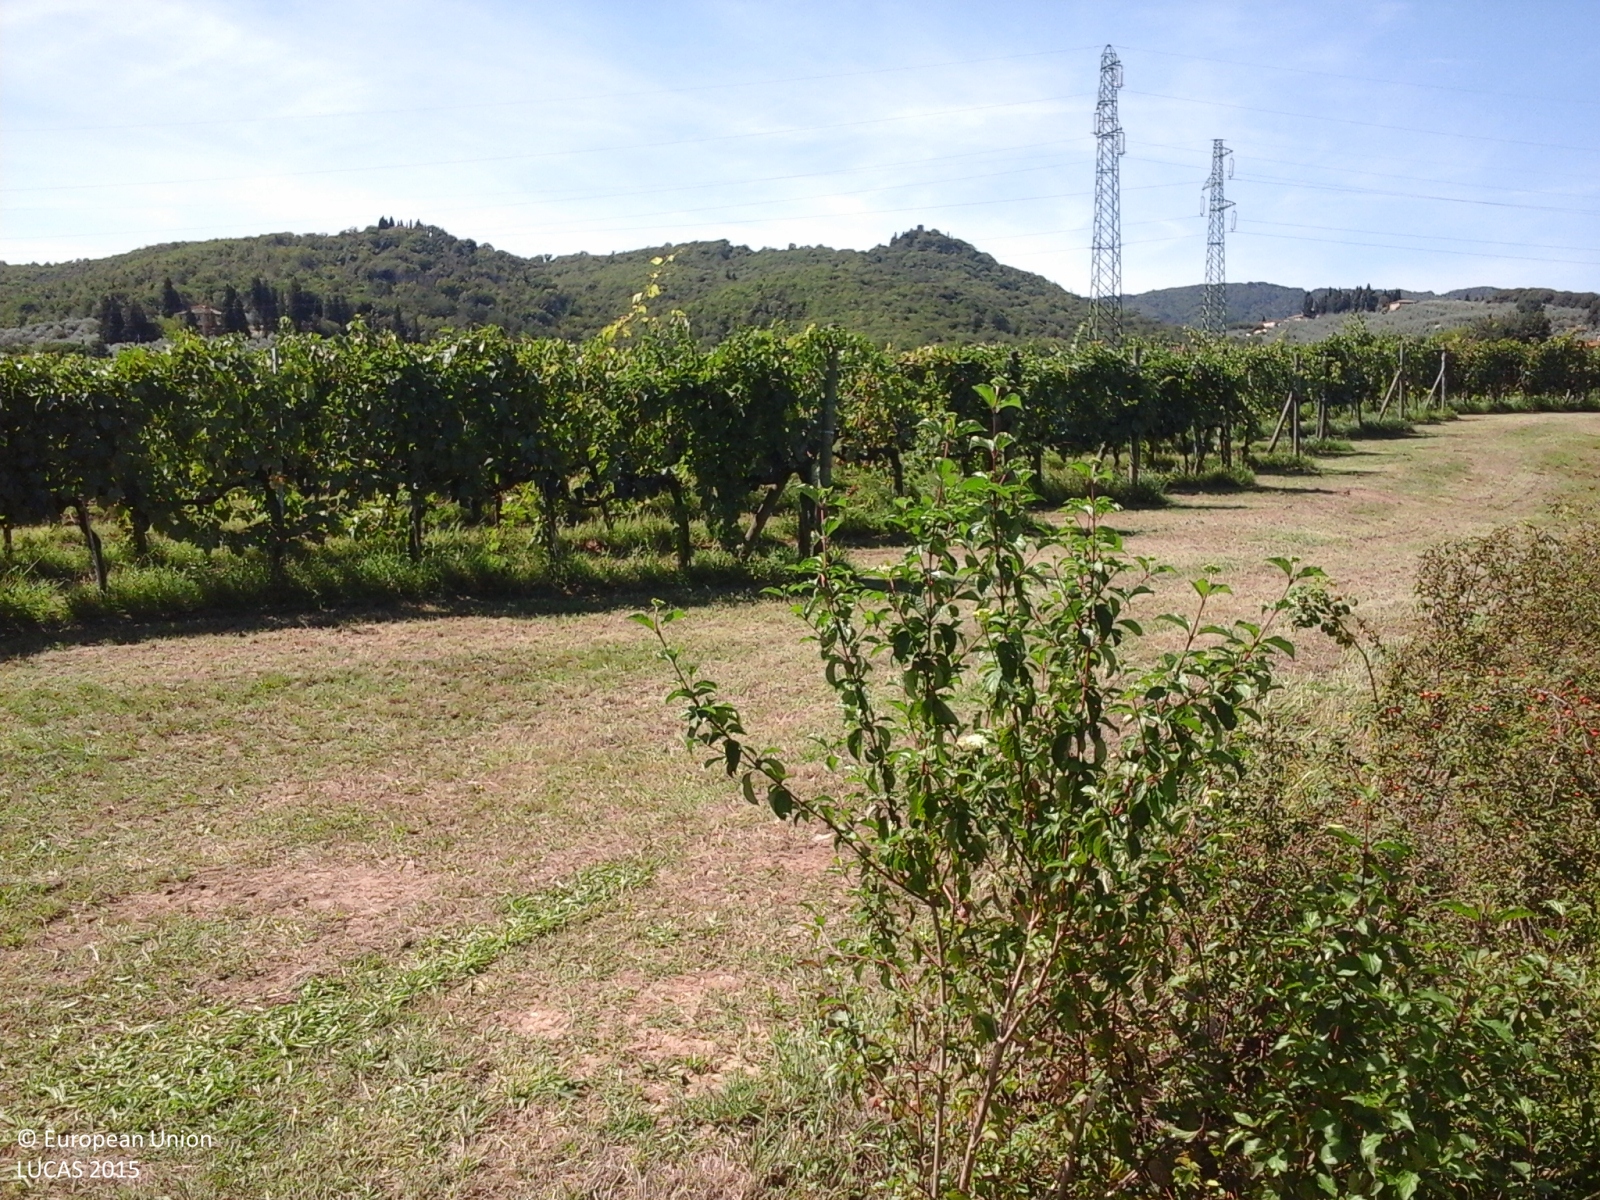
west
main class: Cropland
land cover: Vineyards
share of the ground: 25 - 50 %
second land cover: Grassland without tree/shrub cover
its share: > 75 %
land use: Agriculture (excluding fallow land and kitchen gardens)
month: September
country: IT
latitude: 43.4722
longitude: 11.5903
